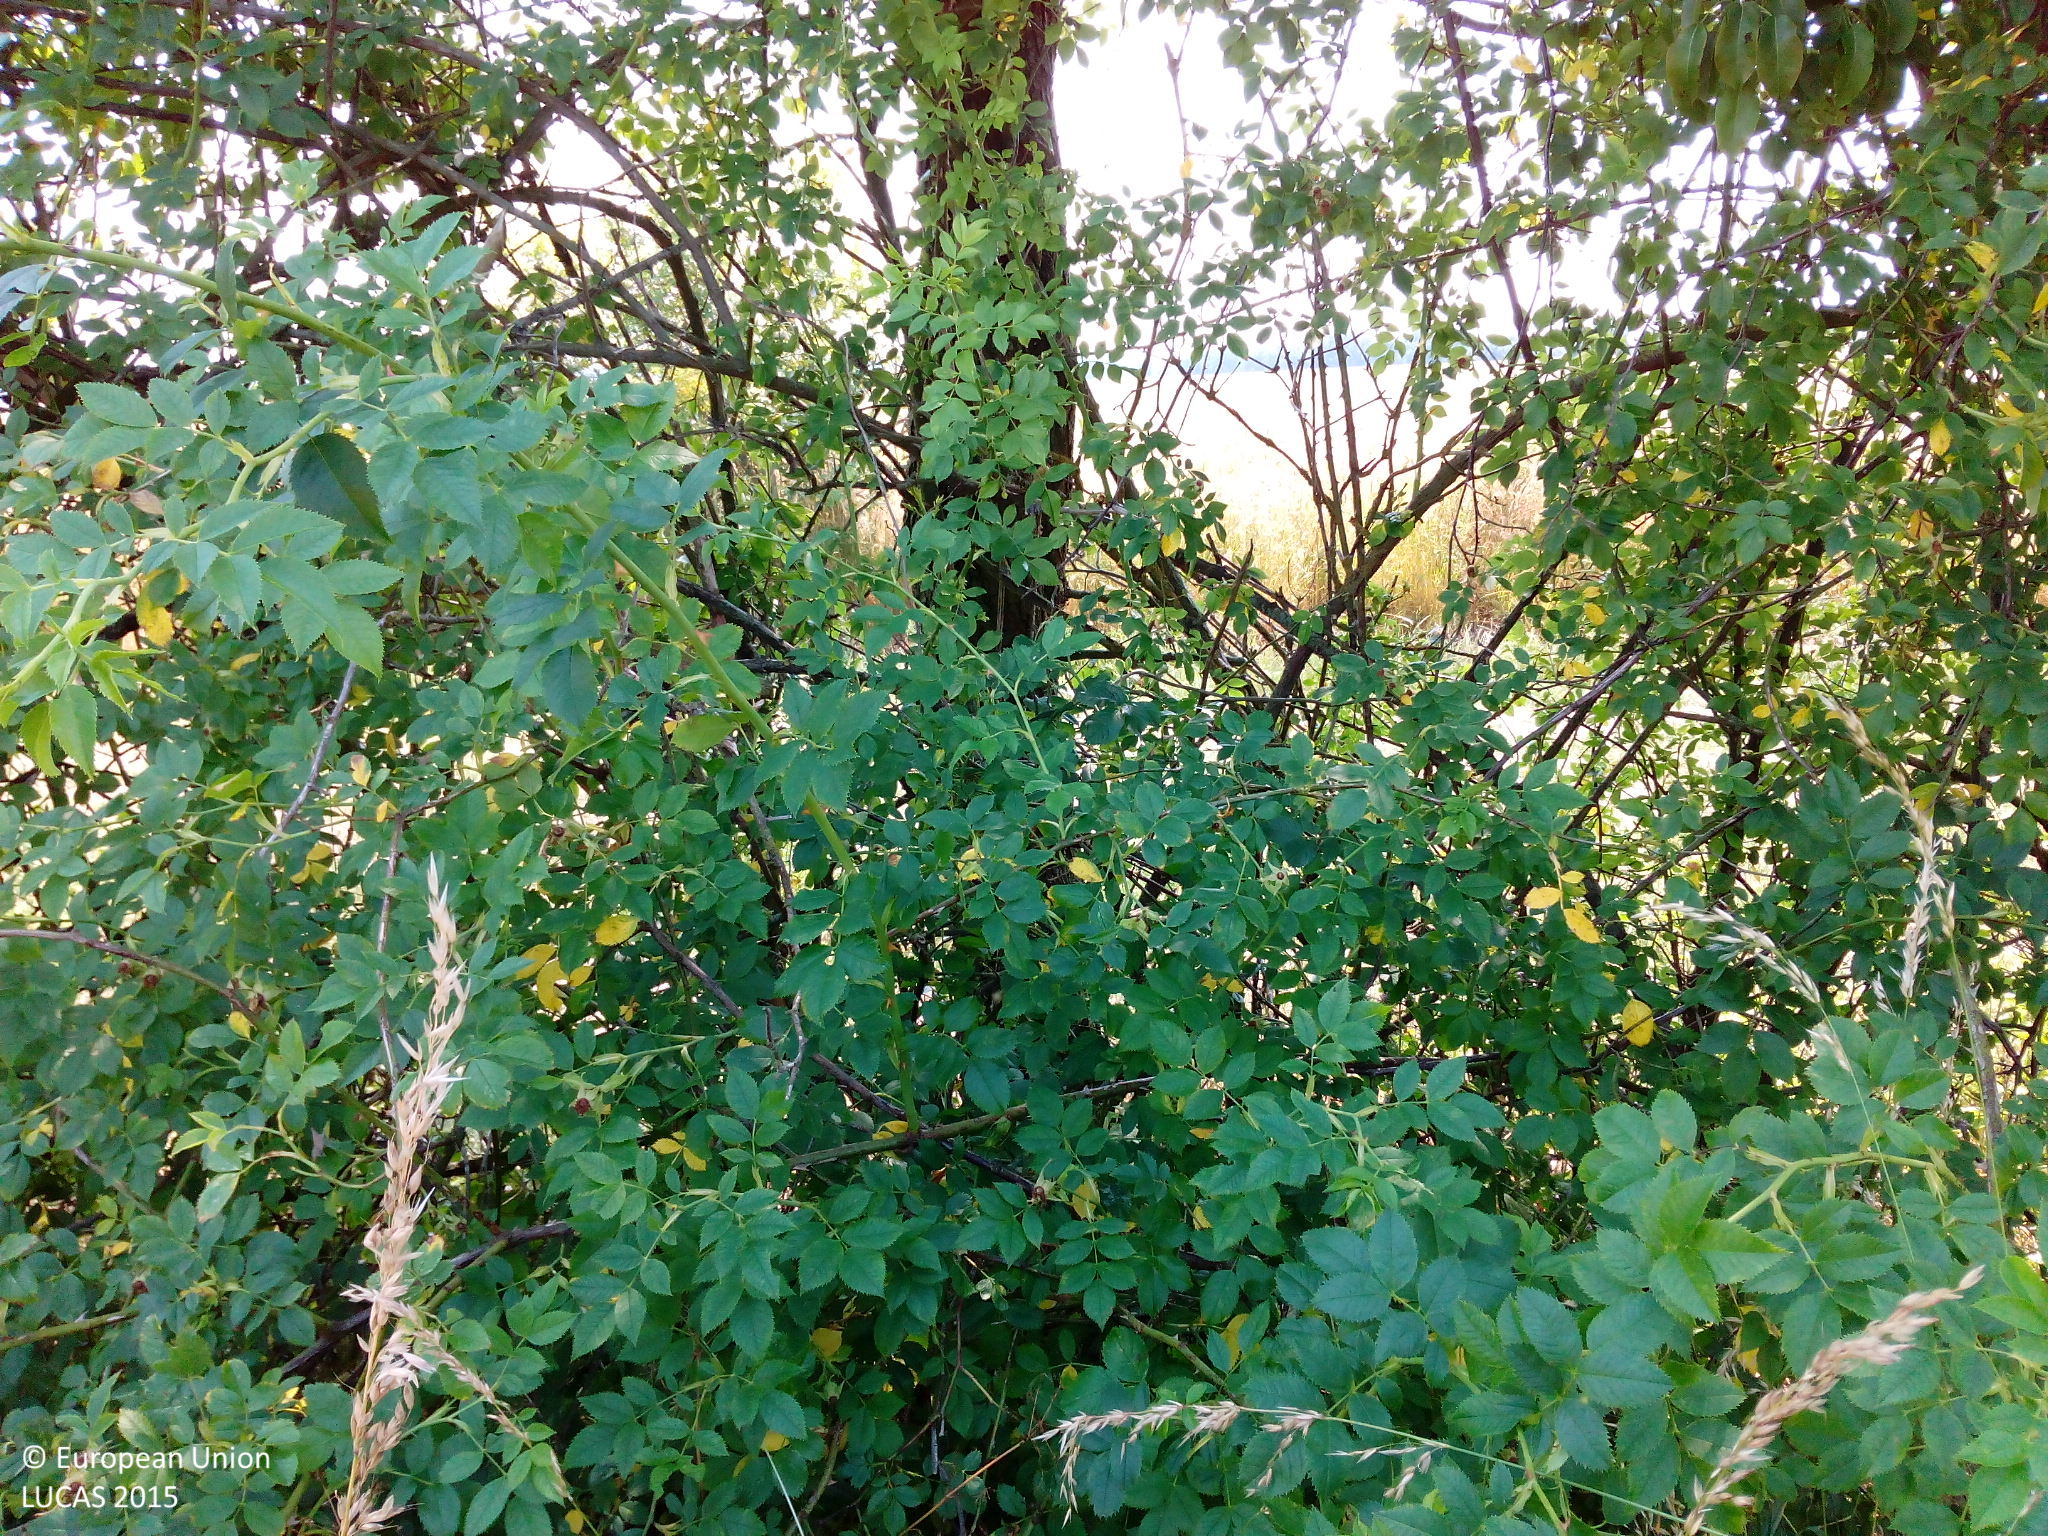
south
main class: Cropland
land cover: Rape and turnip rape
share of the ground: > 75 %
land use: Agriculture (excluding fallow land and kitchen gardens)
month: July
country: DE
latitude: 52.4495
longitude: 14.1356
